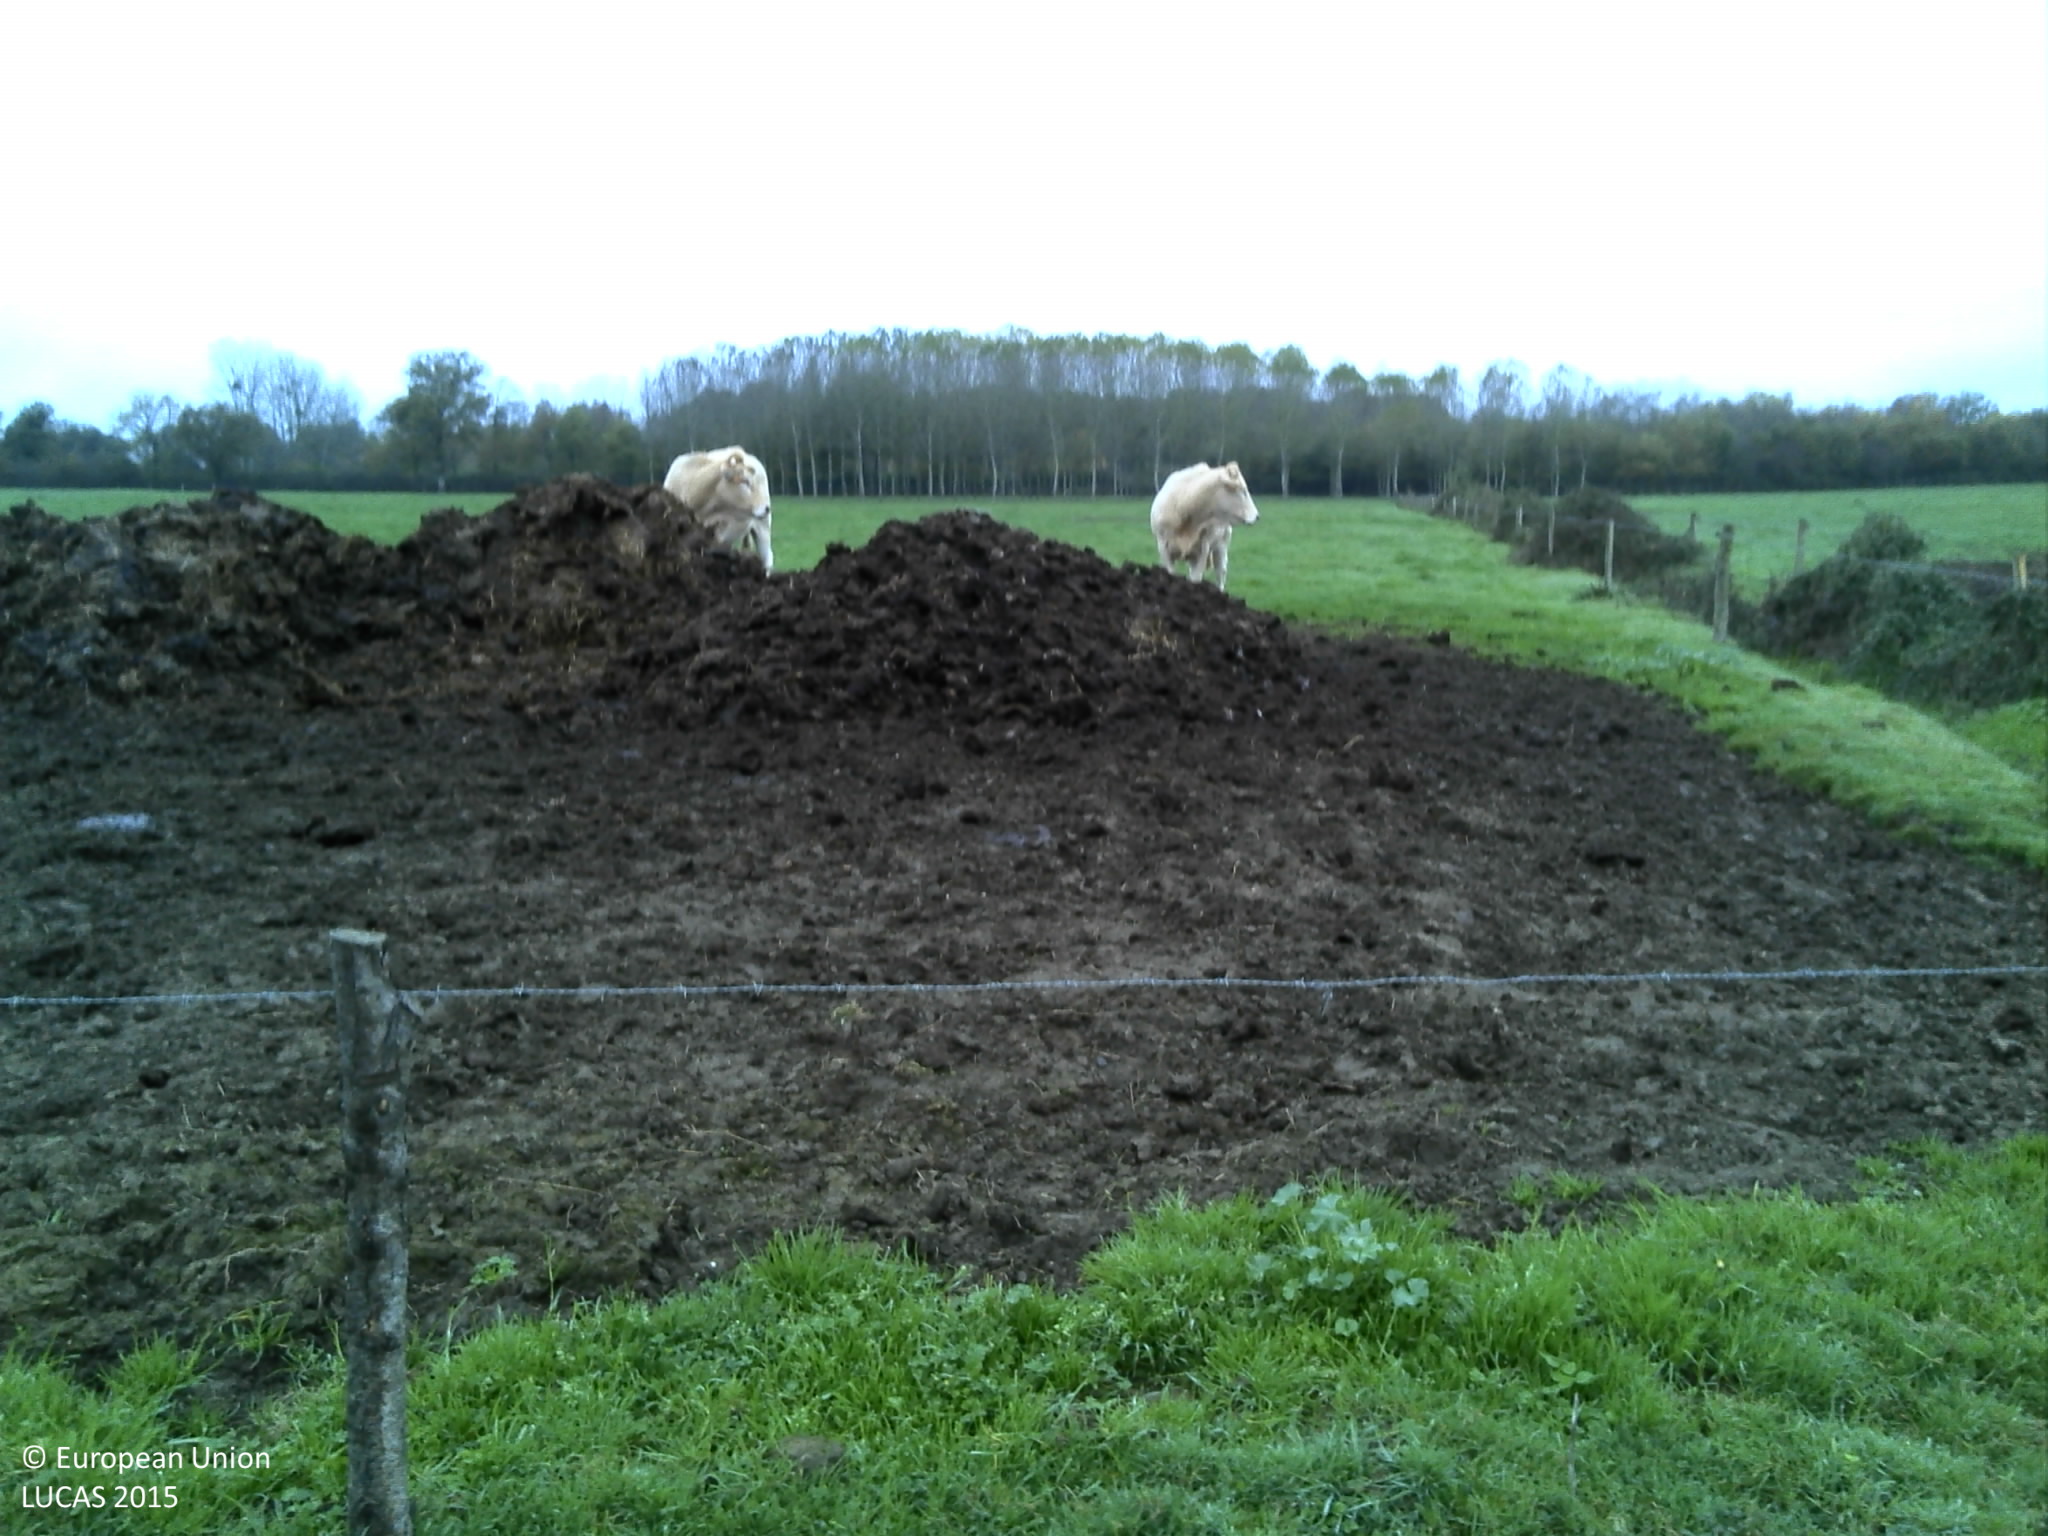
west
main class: Grassland
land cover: Grassland without tree/shrub cover
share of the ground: > 75 %
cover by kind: herbaceous plants 100 %
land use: Agriculture (excluding fallow land and kitchen gardens)
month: November
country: FR
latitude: 47.6867
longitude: -1.3795
